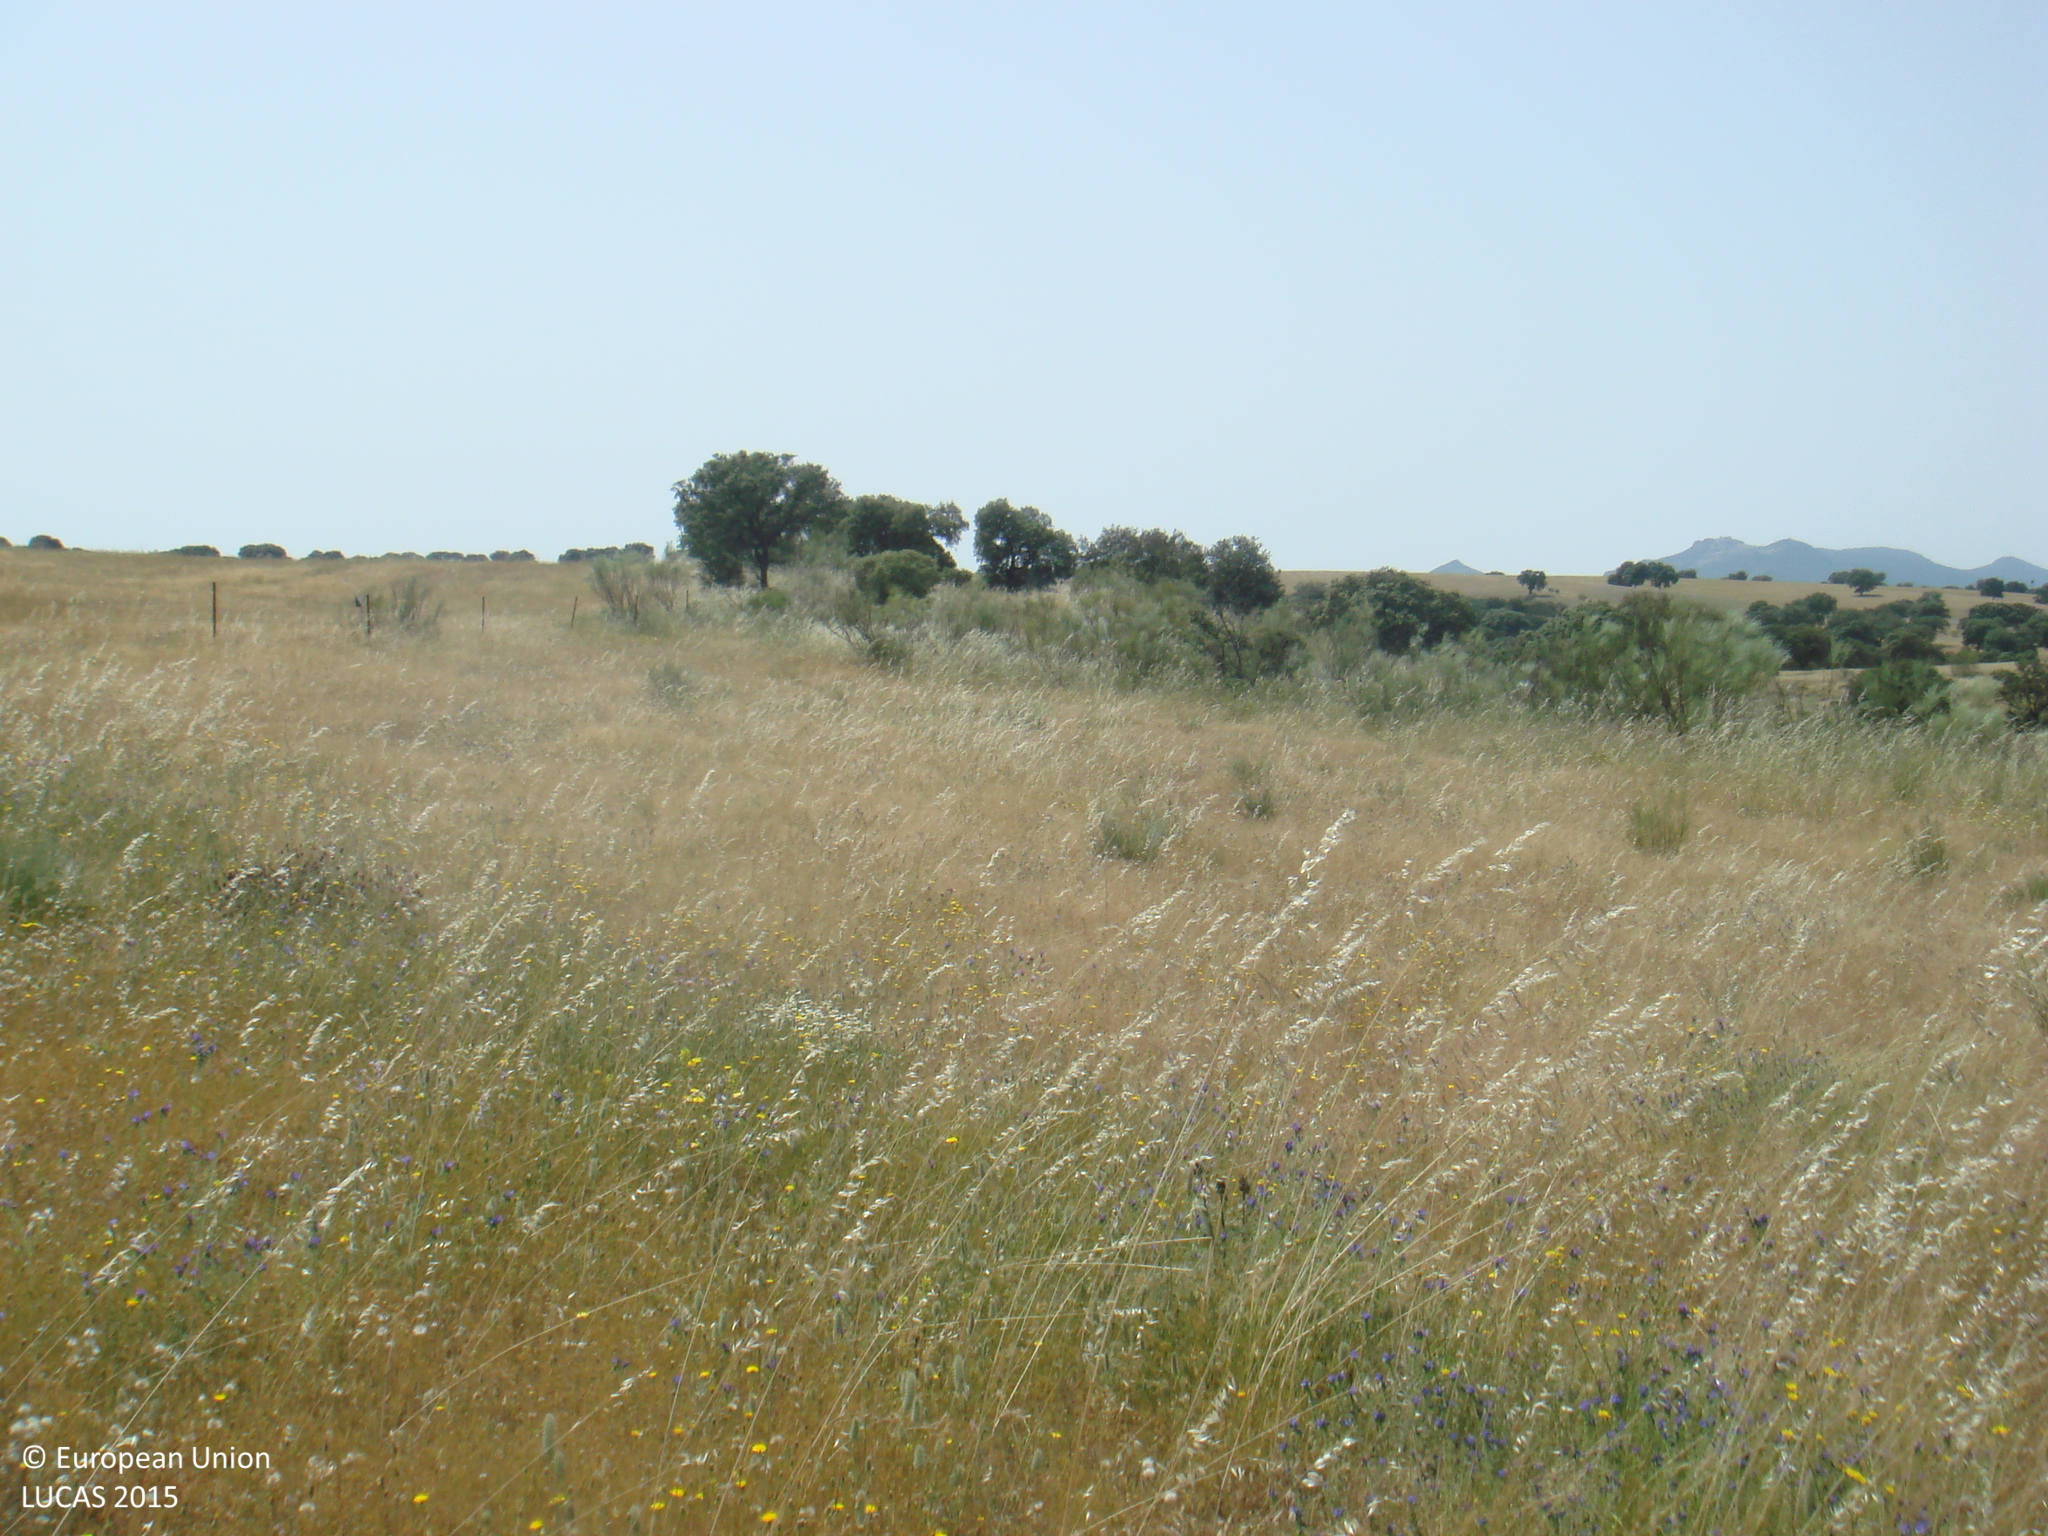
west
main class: Grassland
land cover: Grassland with sparse tree/shrub cover
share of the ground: > 75 %
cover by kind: herbaceous plants 95 %, broadleaved forest trees 5 %
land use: Agriculture (excluding fallow land and kitchen gardens)
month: May
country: ES
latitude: 38.5690
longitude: -4.7971
